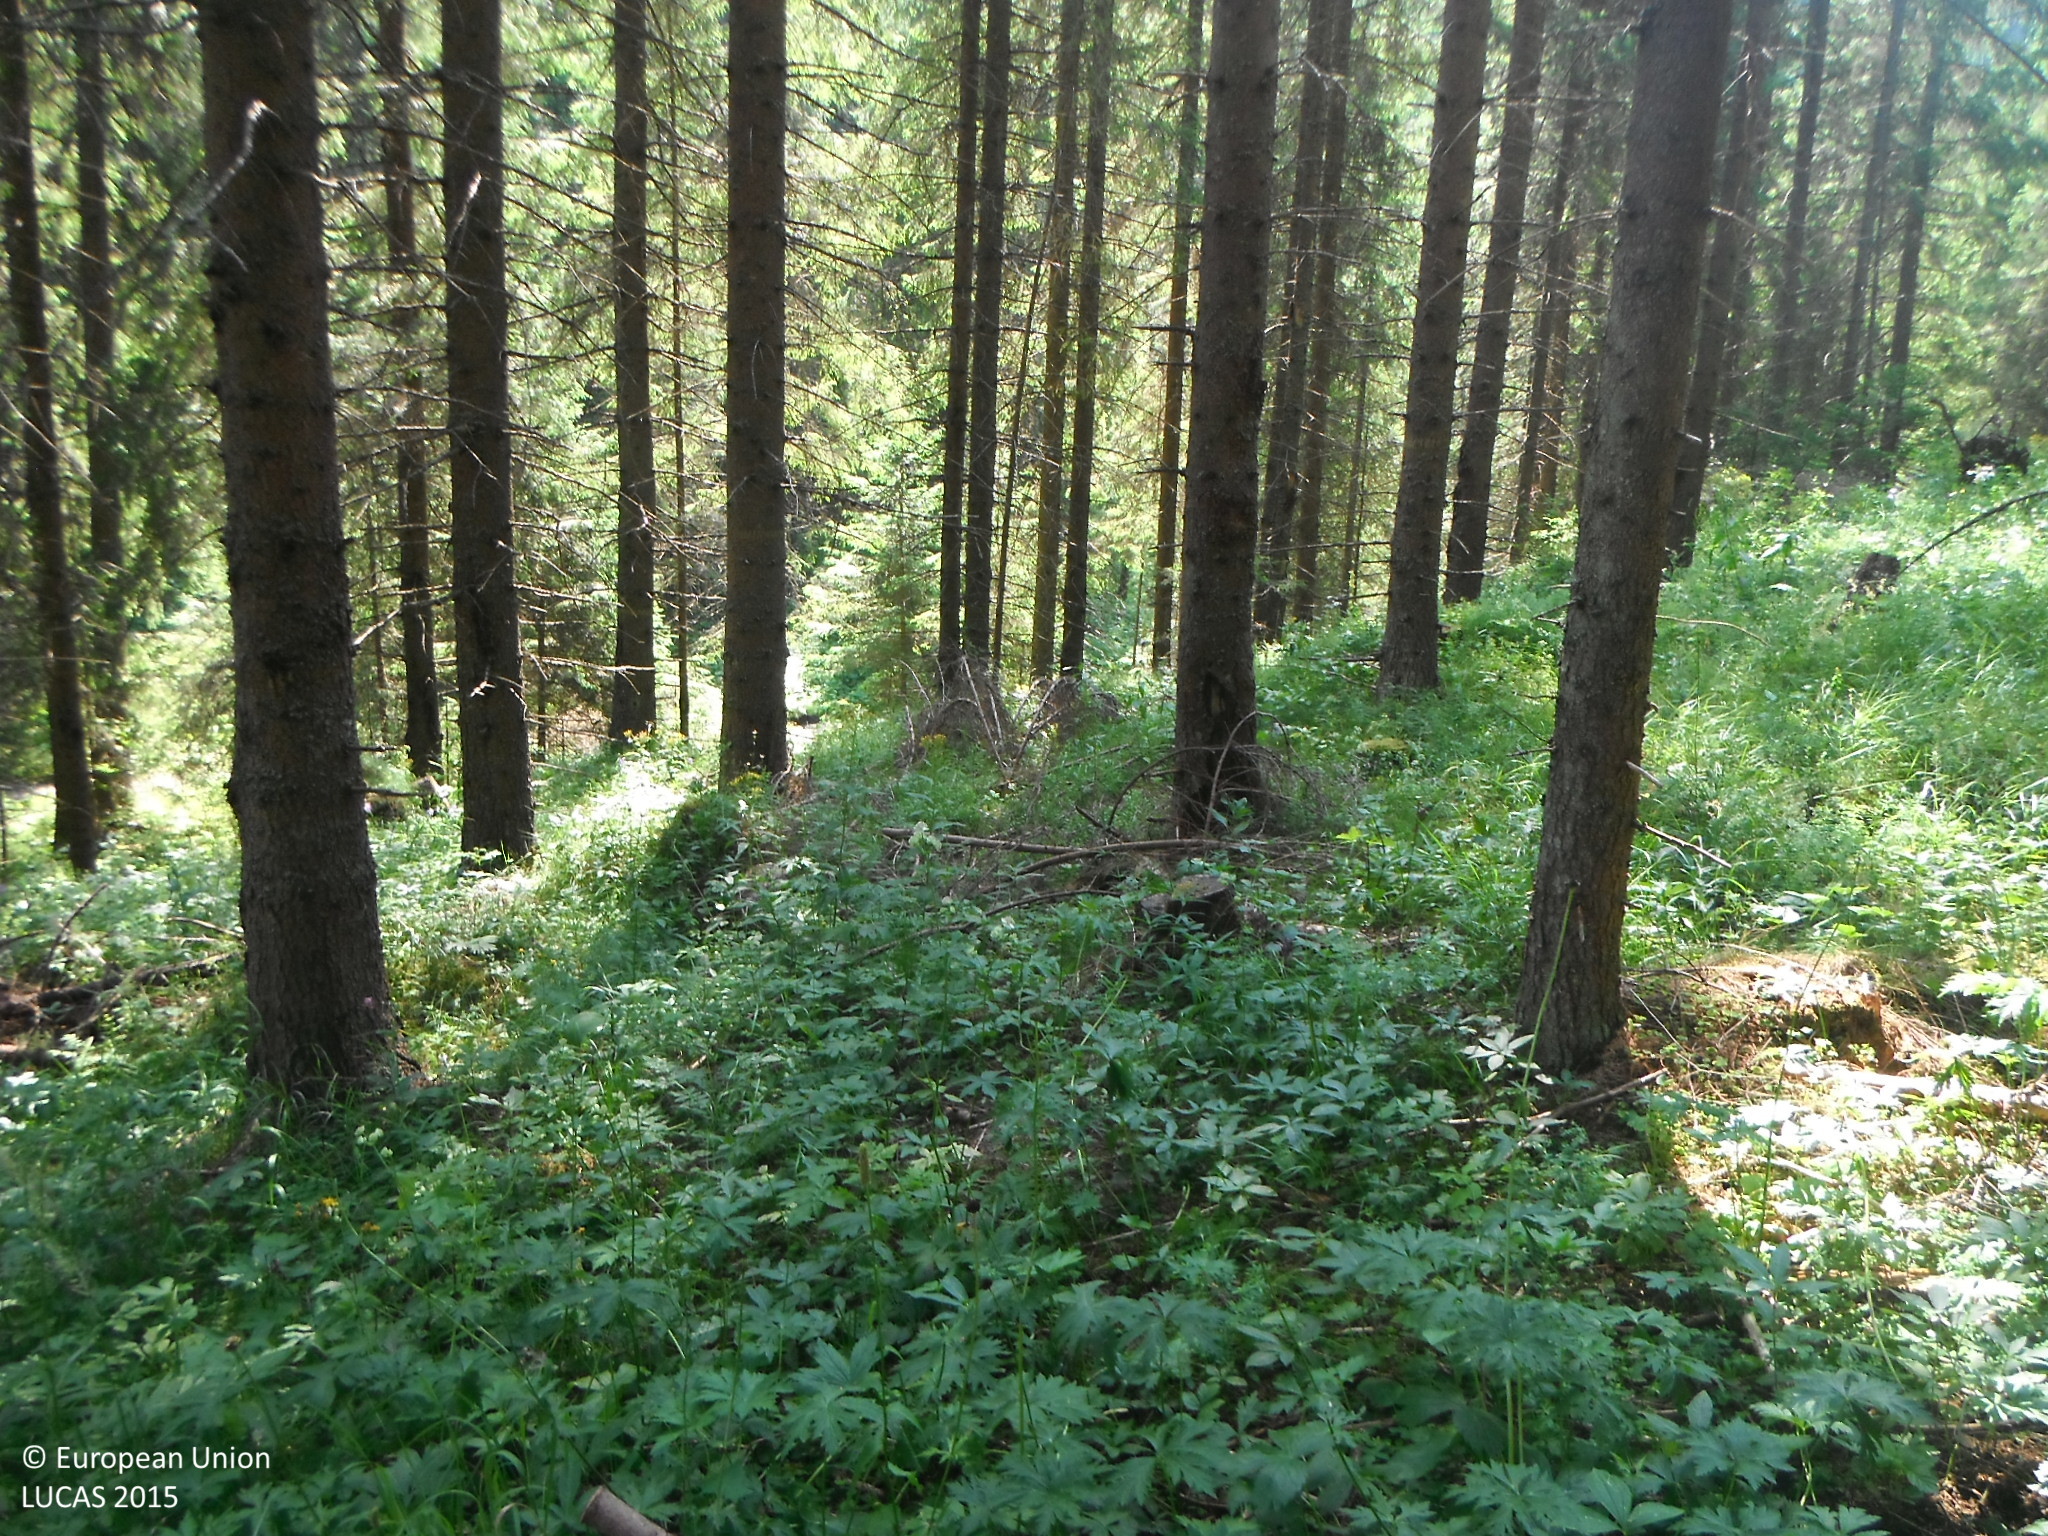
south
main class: Woodland
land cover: Spruce dominated coniferous woodland
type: alpine coniferous forest
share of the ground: > 75 %
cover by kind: coniferous forest trees 100 %
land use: Forestry
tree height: > 5 m
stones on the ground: > 50 %
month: July
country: SK
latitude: 49.2861
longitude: 20.2486
